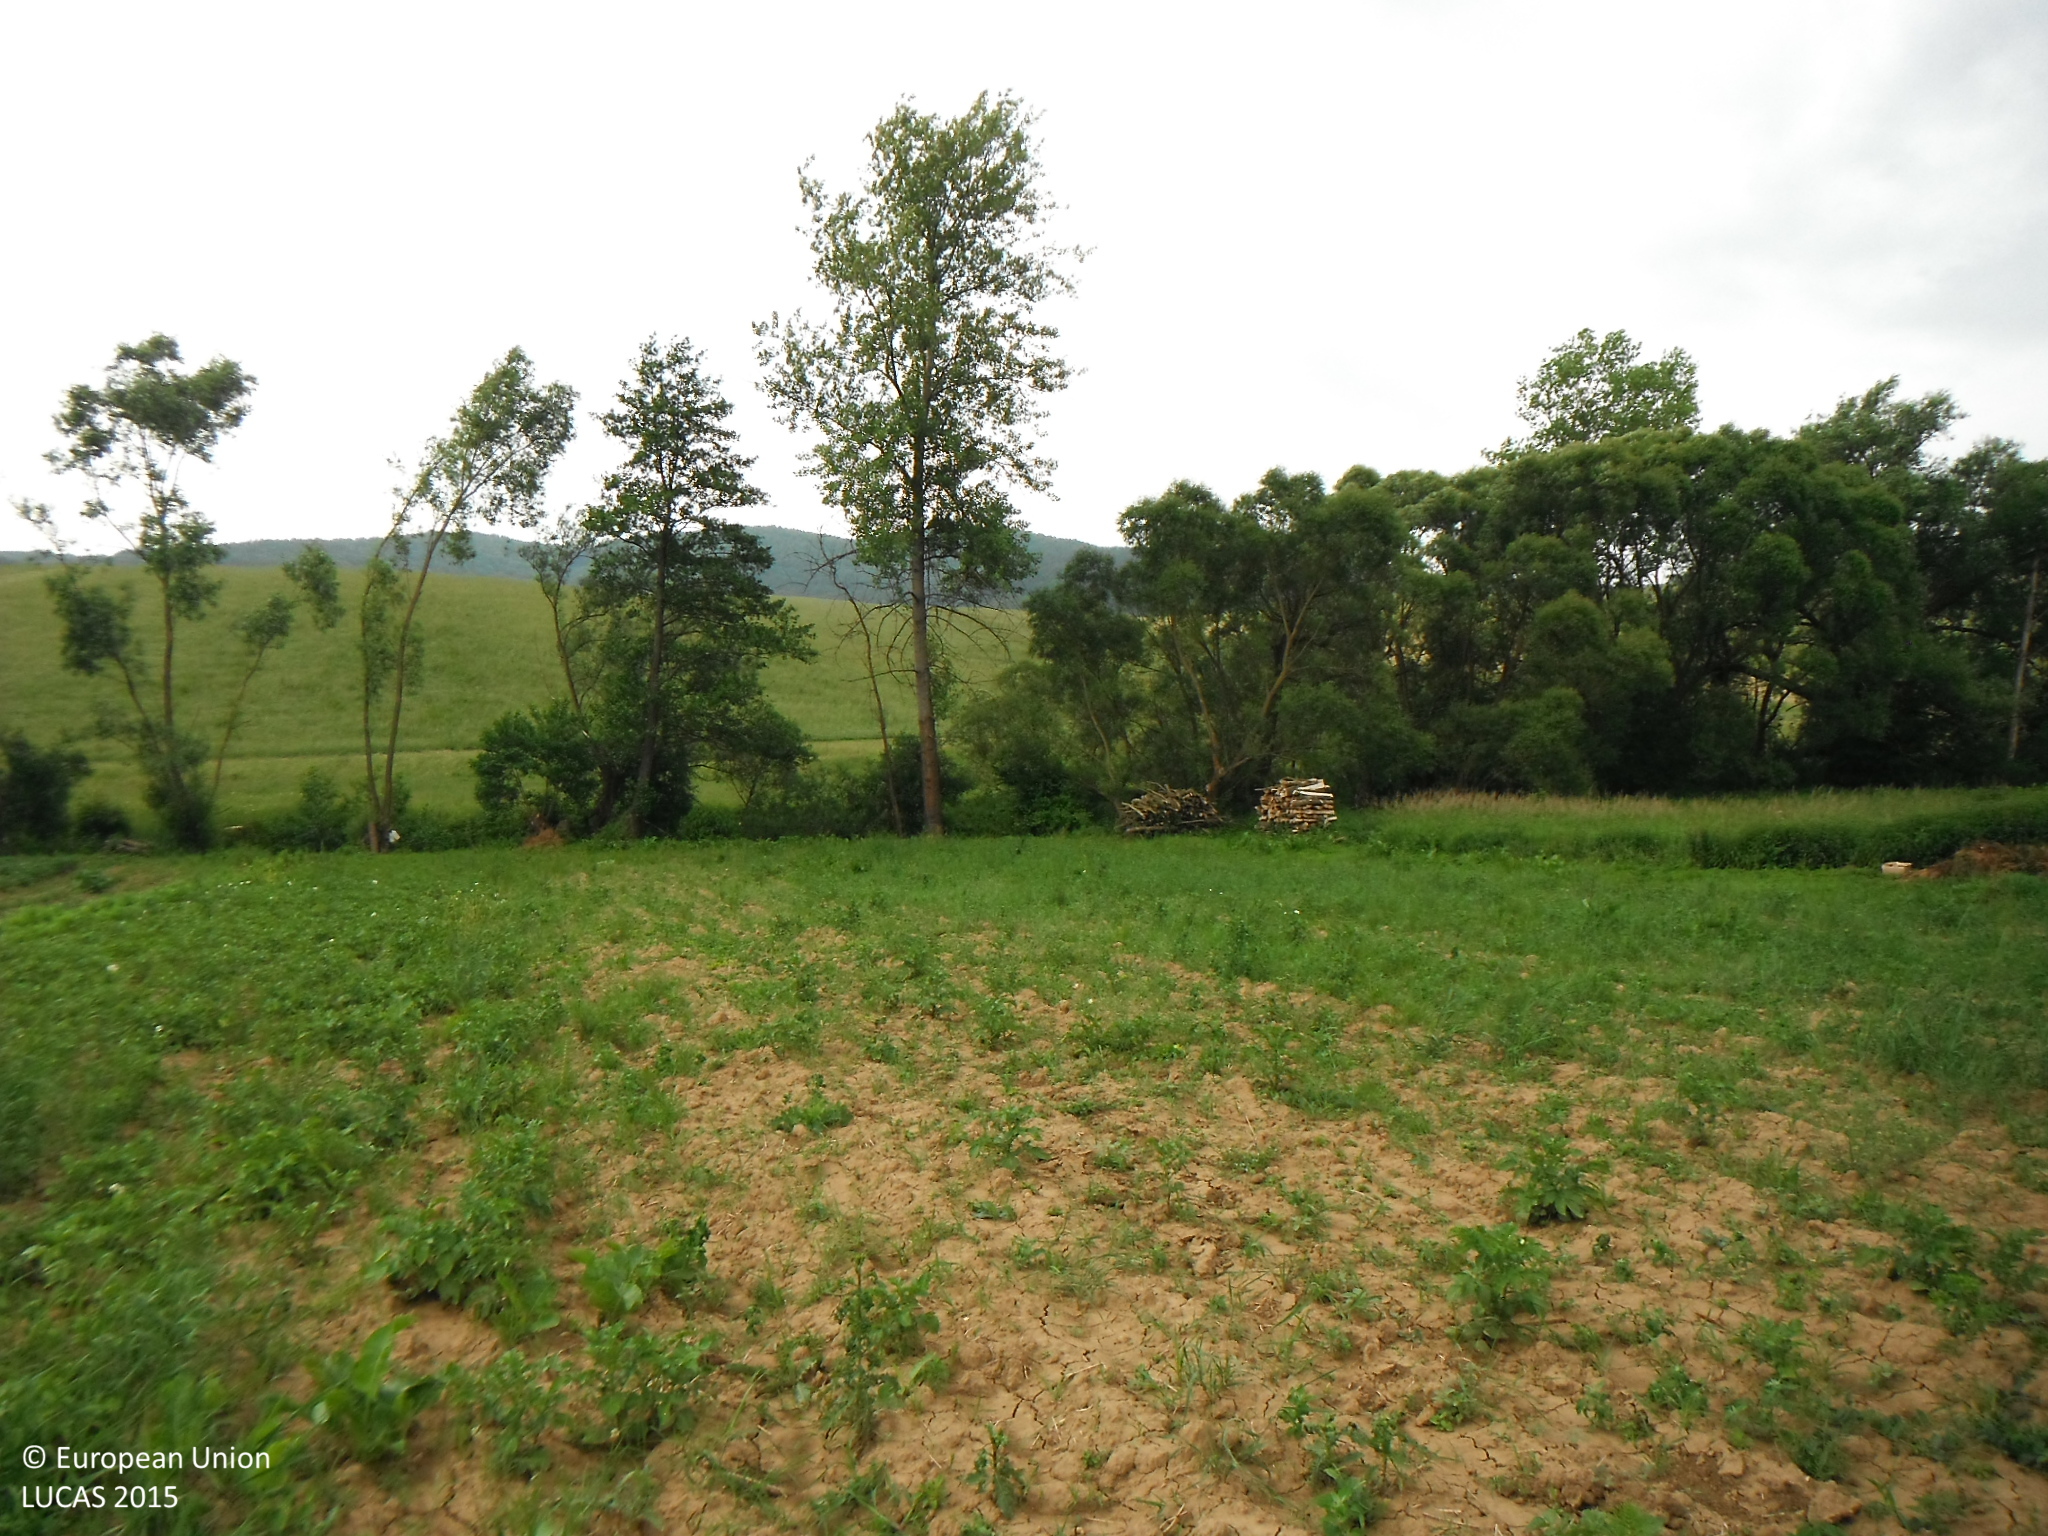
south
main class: Cropland
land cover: Potatoes
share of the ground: 25 - 50 %
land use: Kitchen garden
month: June
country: SK
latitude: 49.1398
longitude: 21.3831
